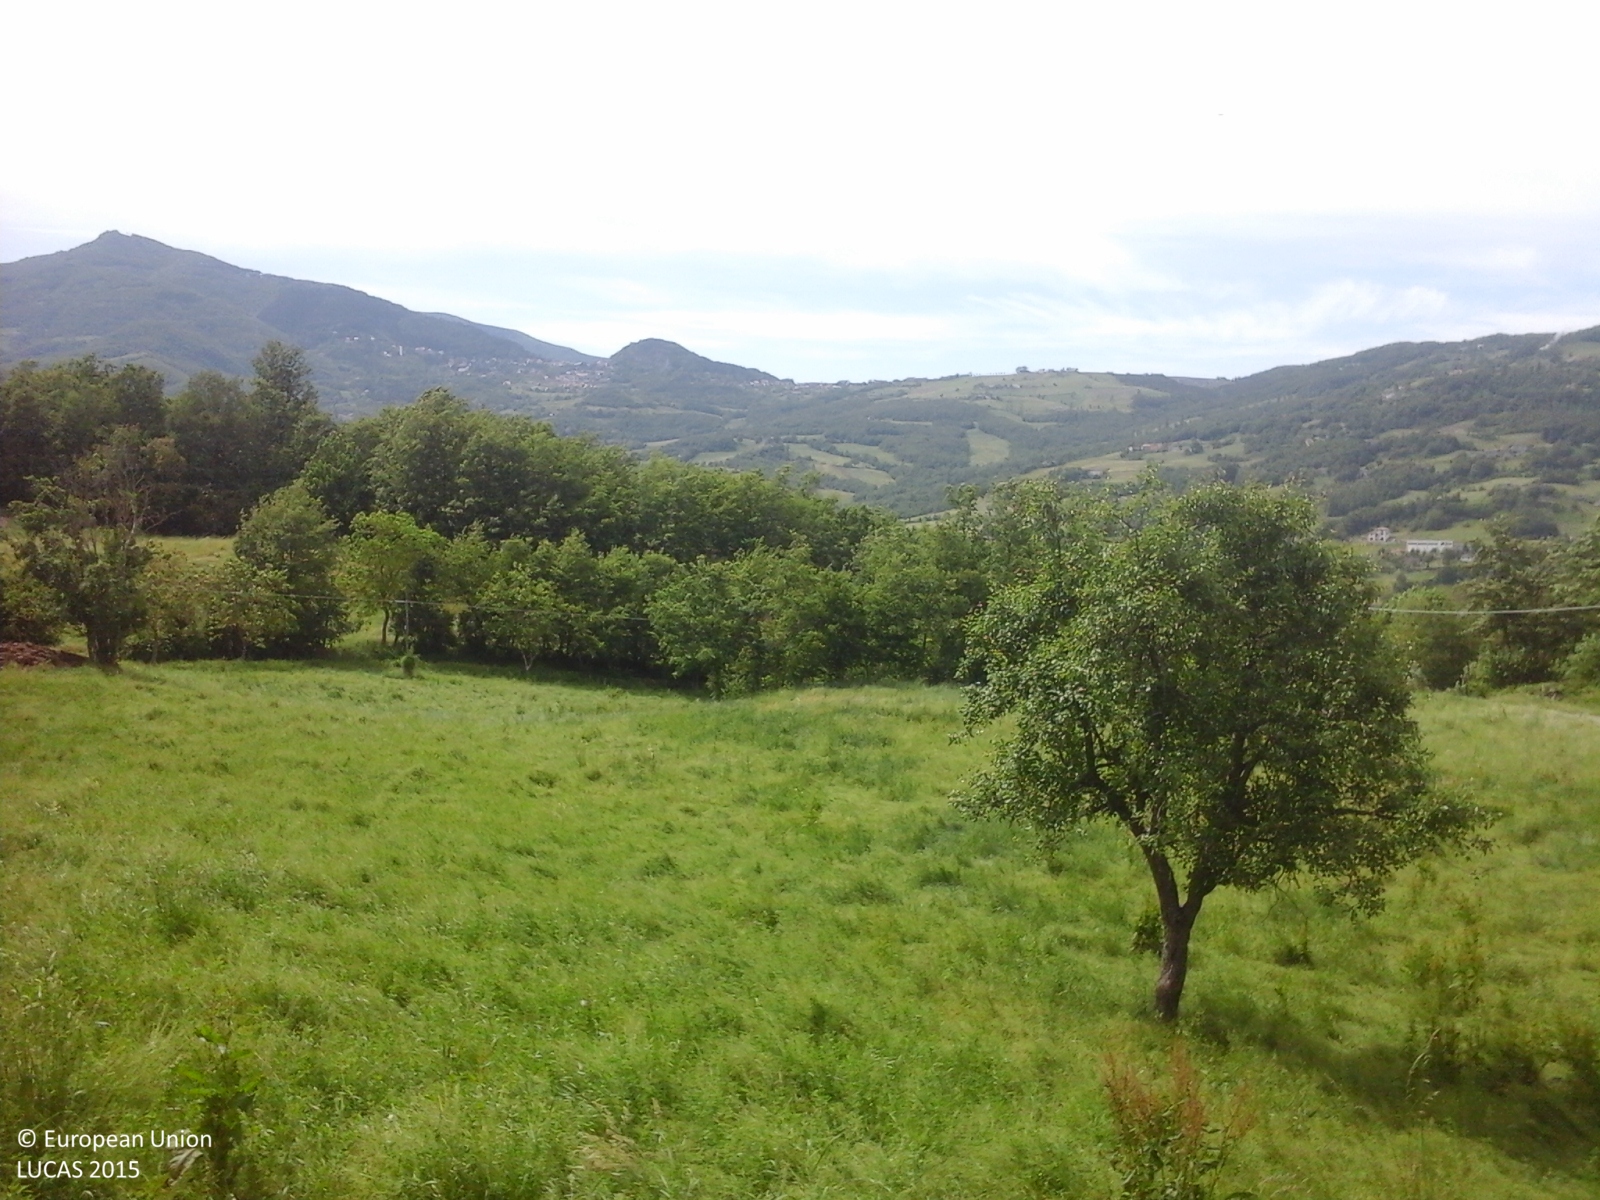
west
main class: Cropland
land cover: Lucerne
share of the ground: > 75 %
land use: Agriculture (excluding fallow land and kitchen gardens)
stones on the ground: 10 - 25 %
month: May
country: IT
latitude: 44.2209
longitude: 10.8367
